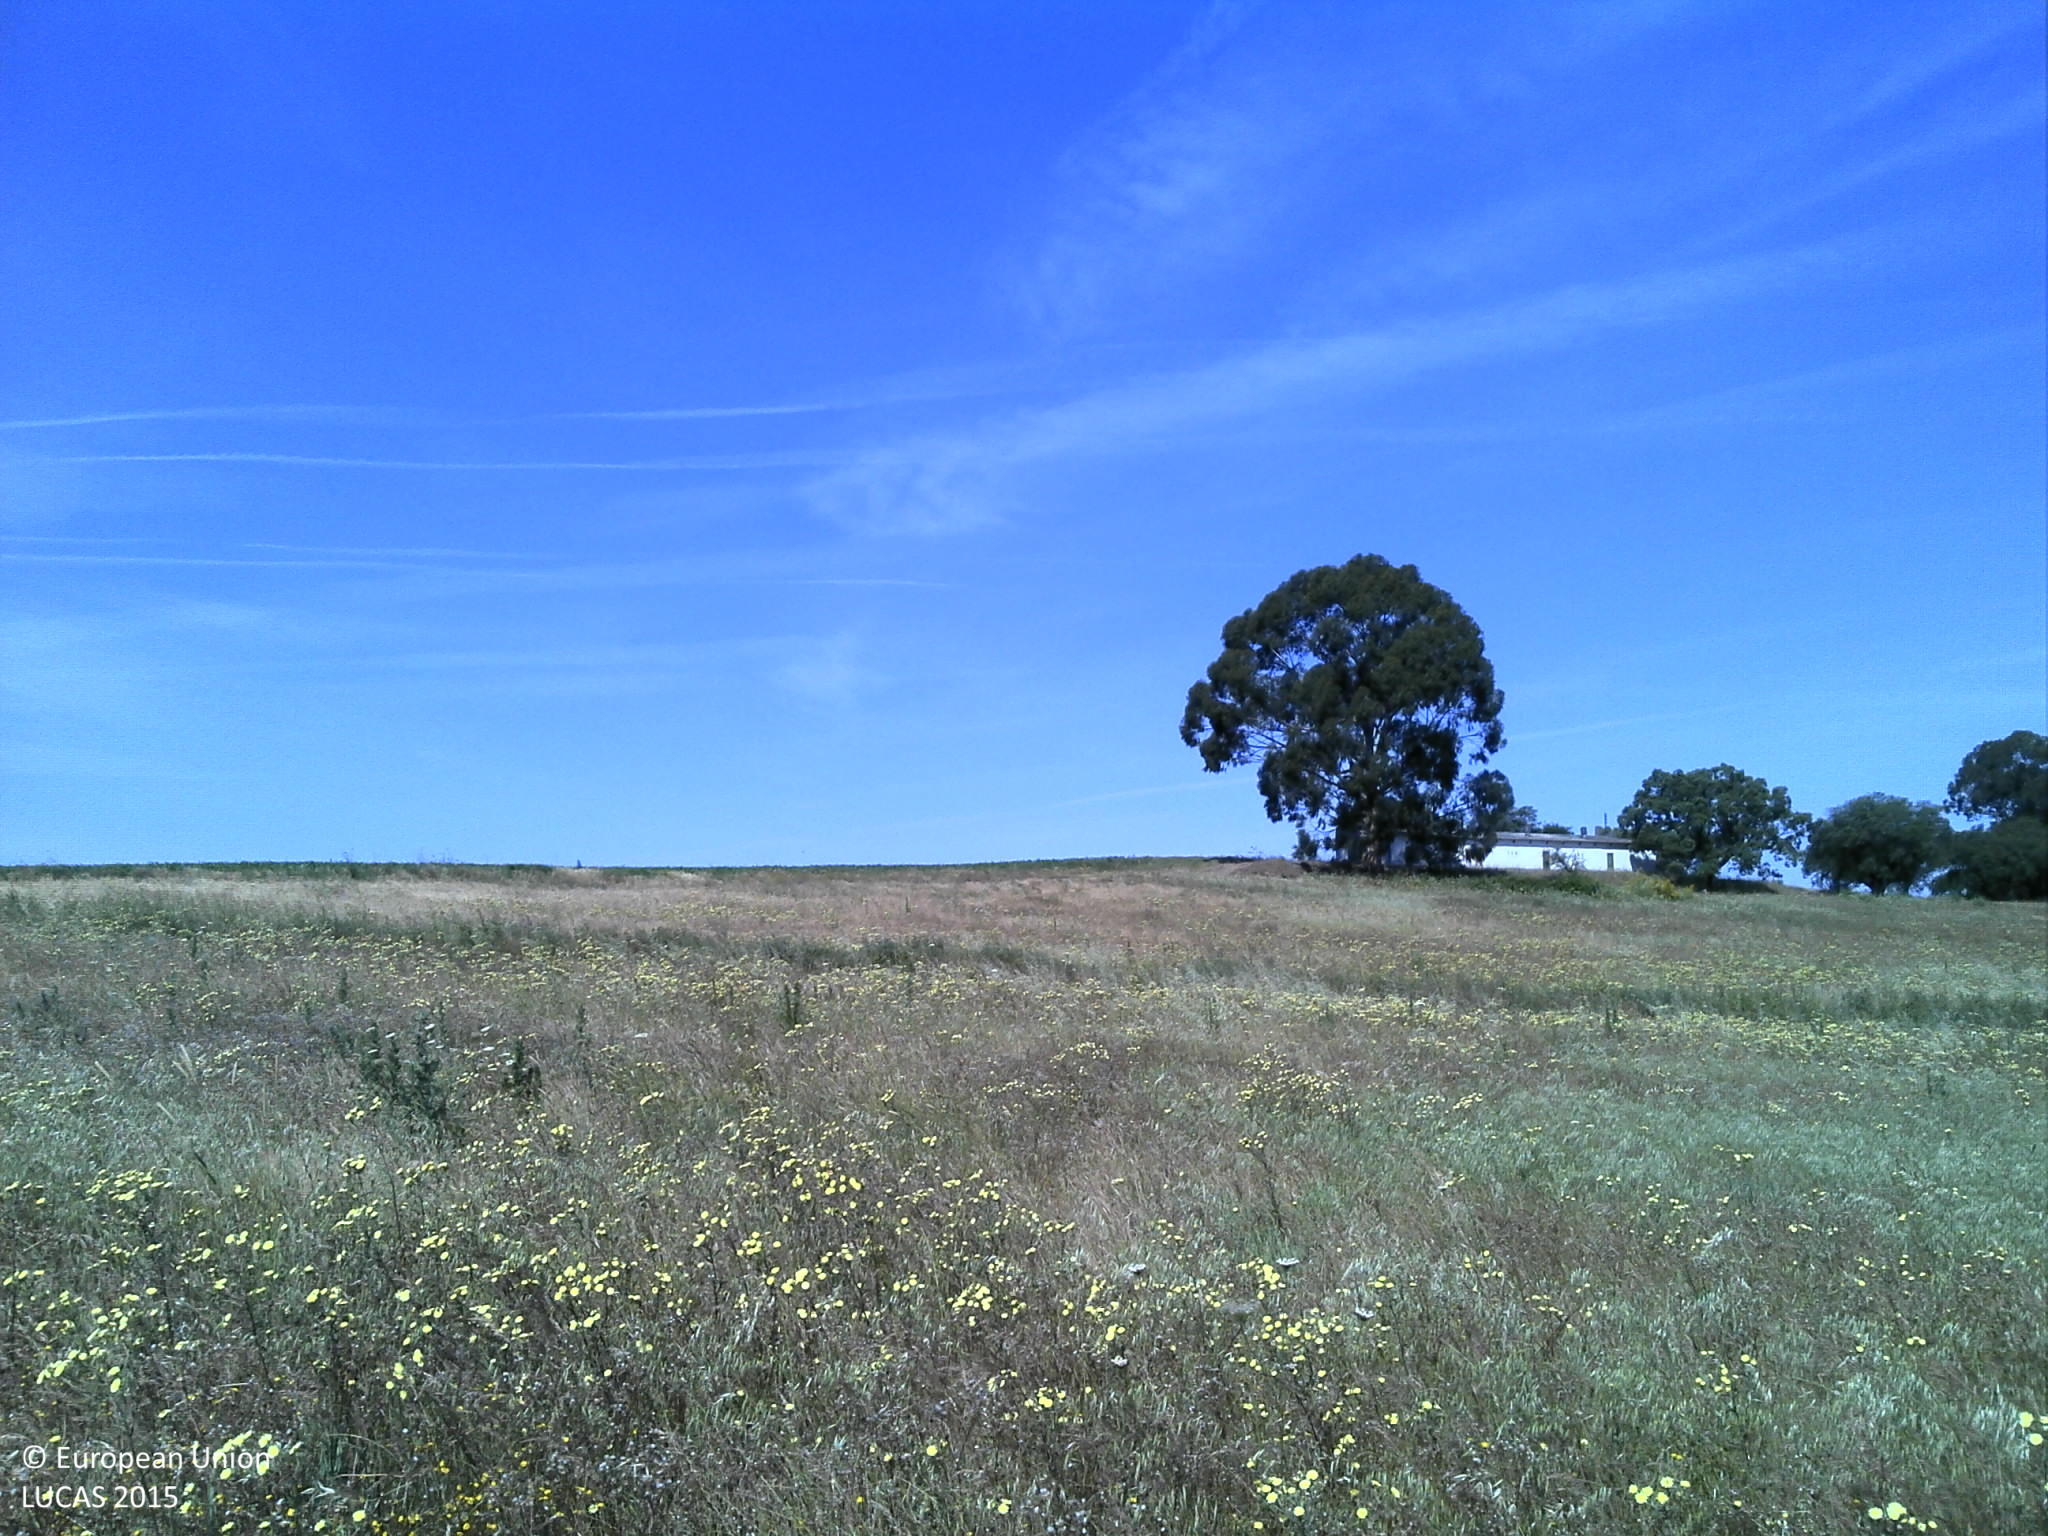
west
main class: Grassland
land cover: Grassland without tree/shrub cover
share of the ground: > 75 %
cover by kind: herbaceous plants 90 %, unconsolidated bare surface 10 %
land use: Agriculture (excluding fallow land and kitchen gardens)
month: May
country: PT
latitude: 39.0822
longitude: -7.6251
